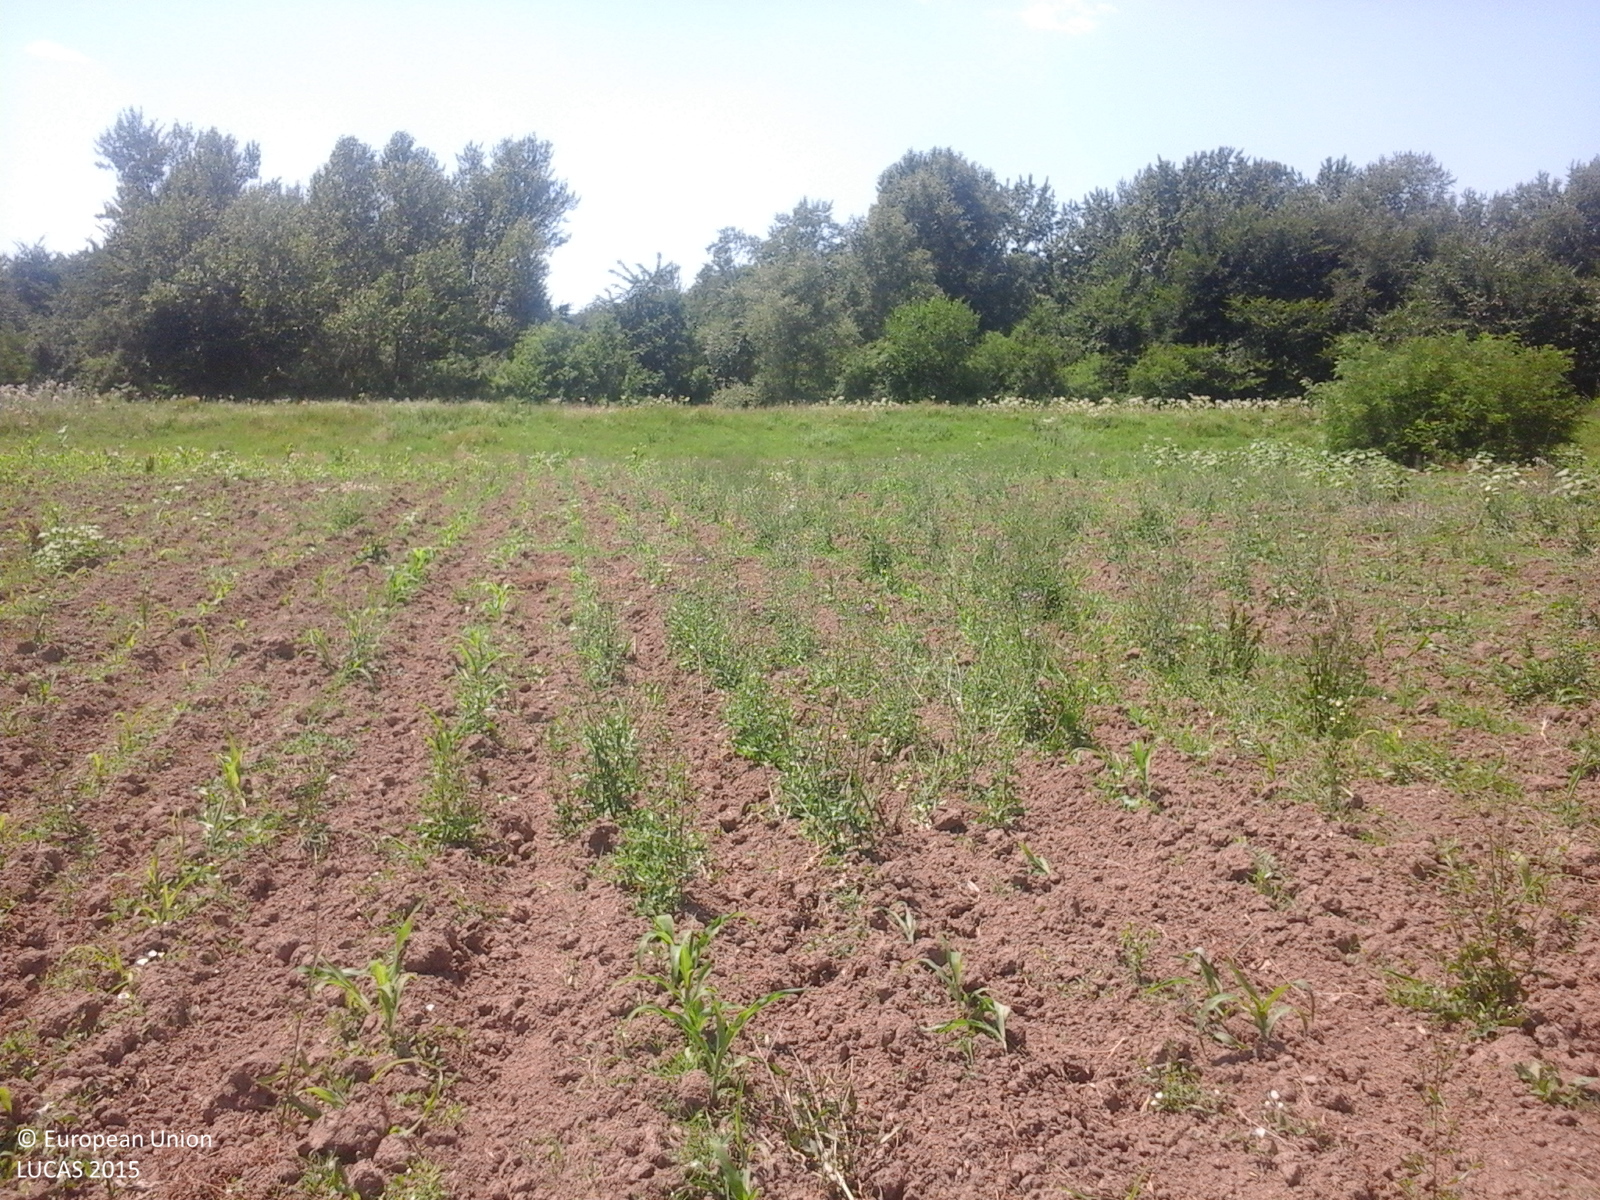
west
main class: Cropland
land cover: Maize
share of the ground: < 10 %
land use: Agriculture (excluding fallow land and kitchen gardens)
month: July
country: RO
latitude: 44.4483
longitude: 24.7140
